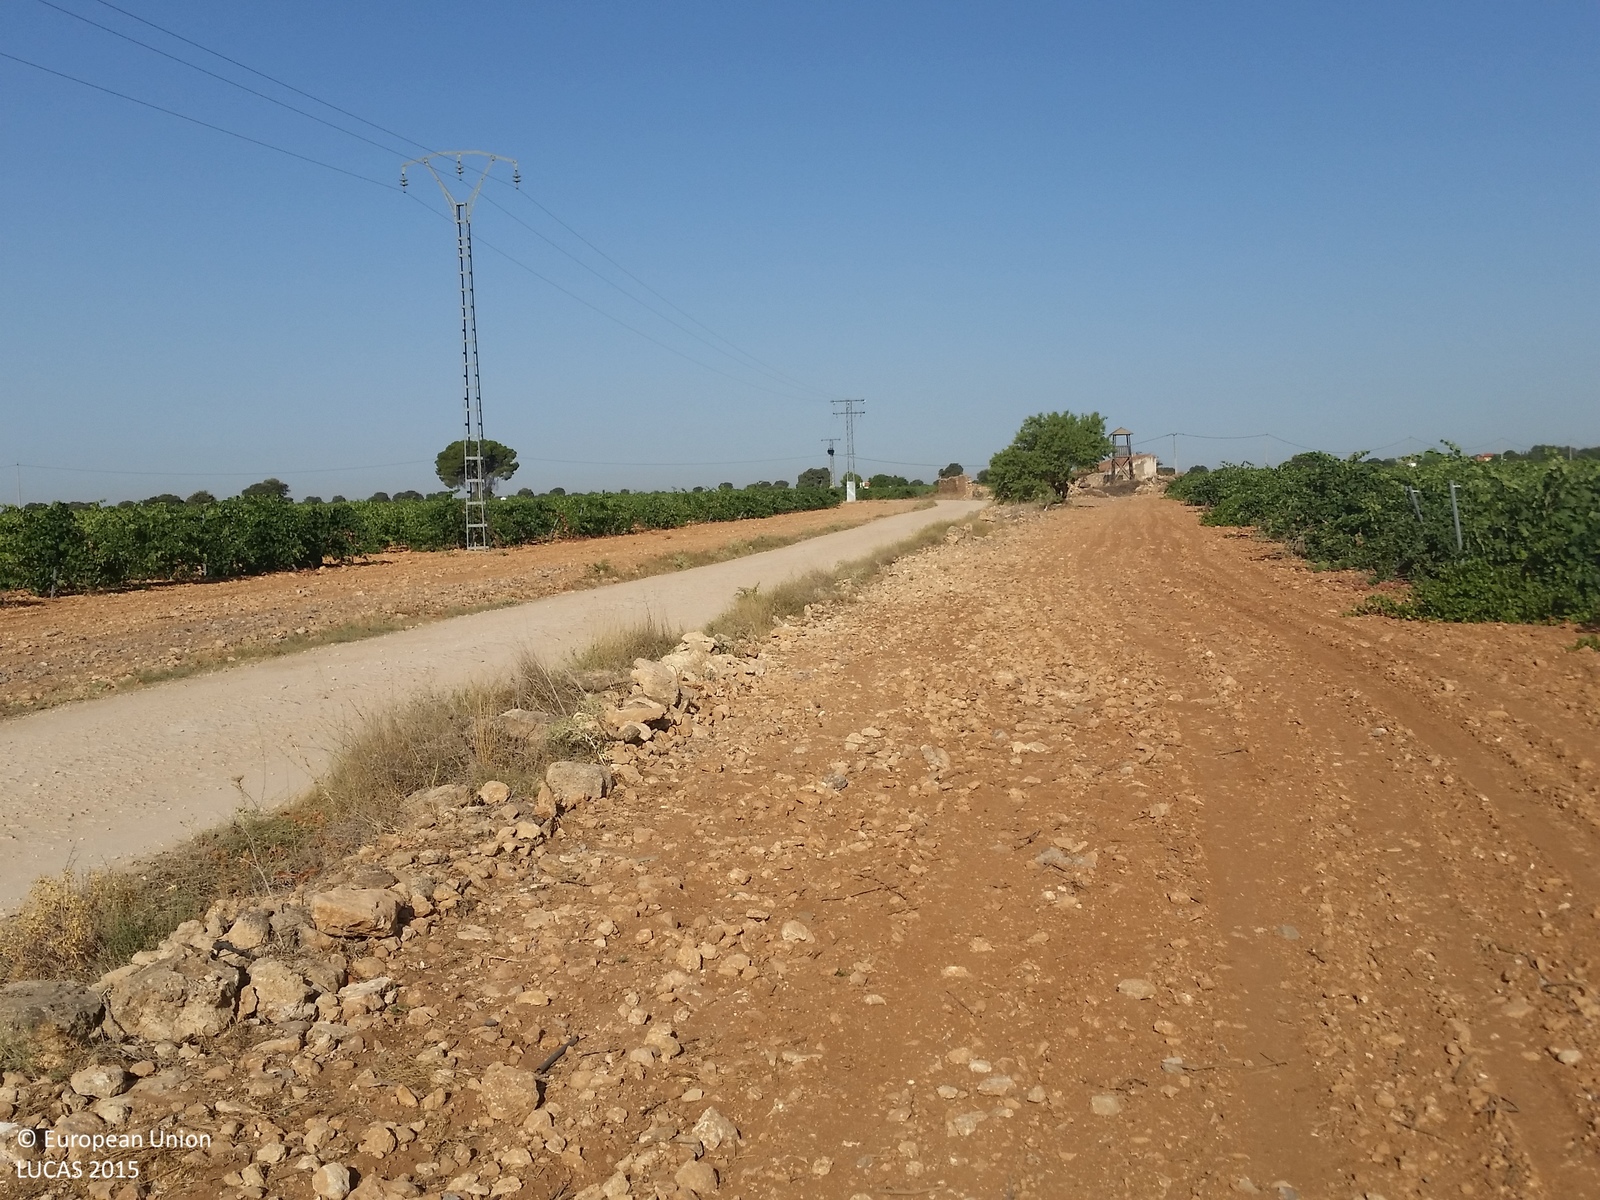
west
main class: Cropland
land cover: Vineyards
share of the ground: 50 - 75 %
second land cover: Other bare soil
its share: > 75 %
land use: Agriculture (excluding fallow land and kitchen gardens)
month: July
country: ES
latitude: 39.2971
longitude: -2.6615
